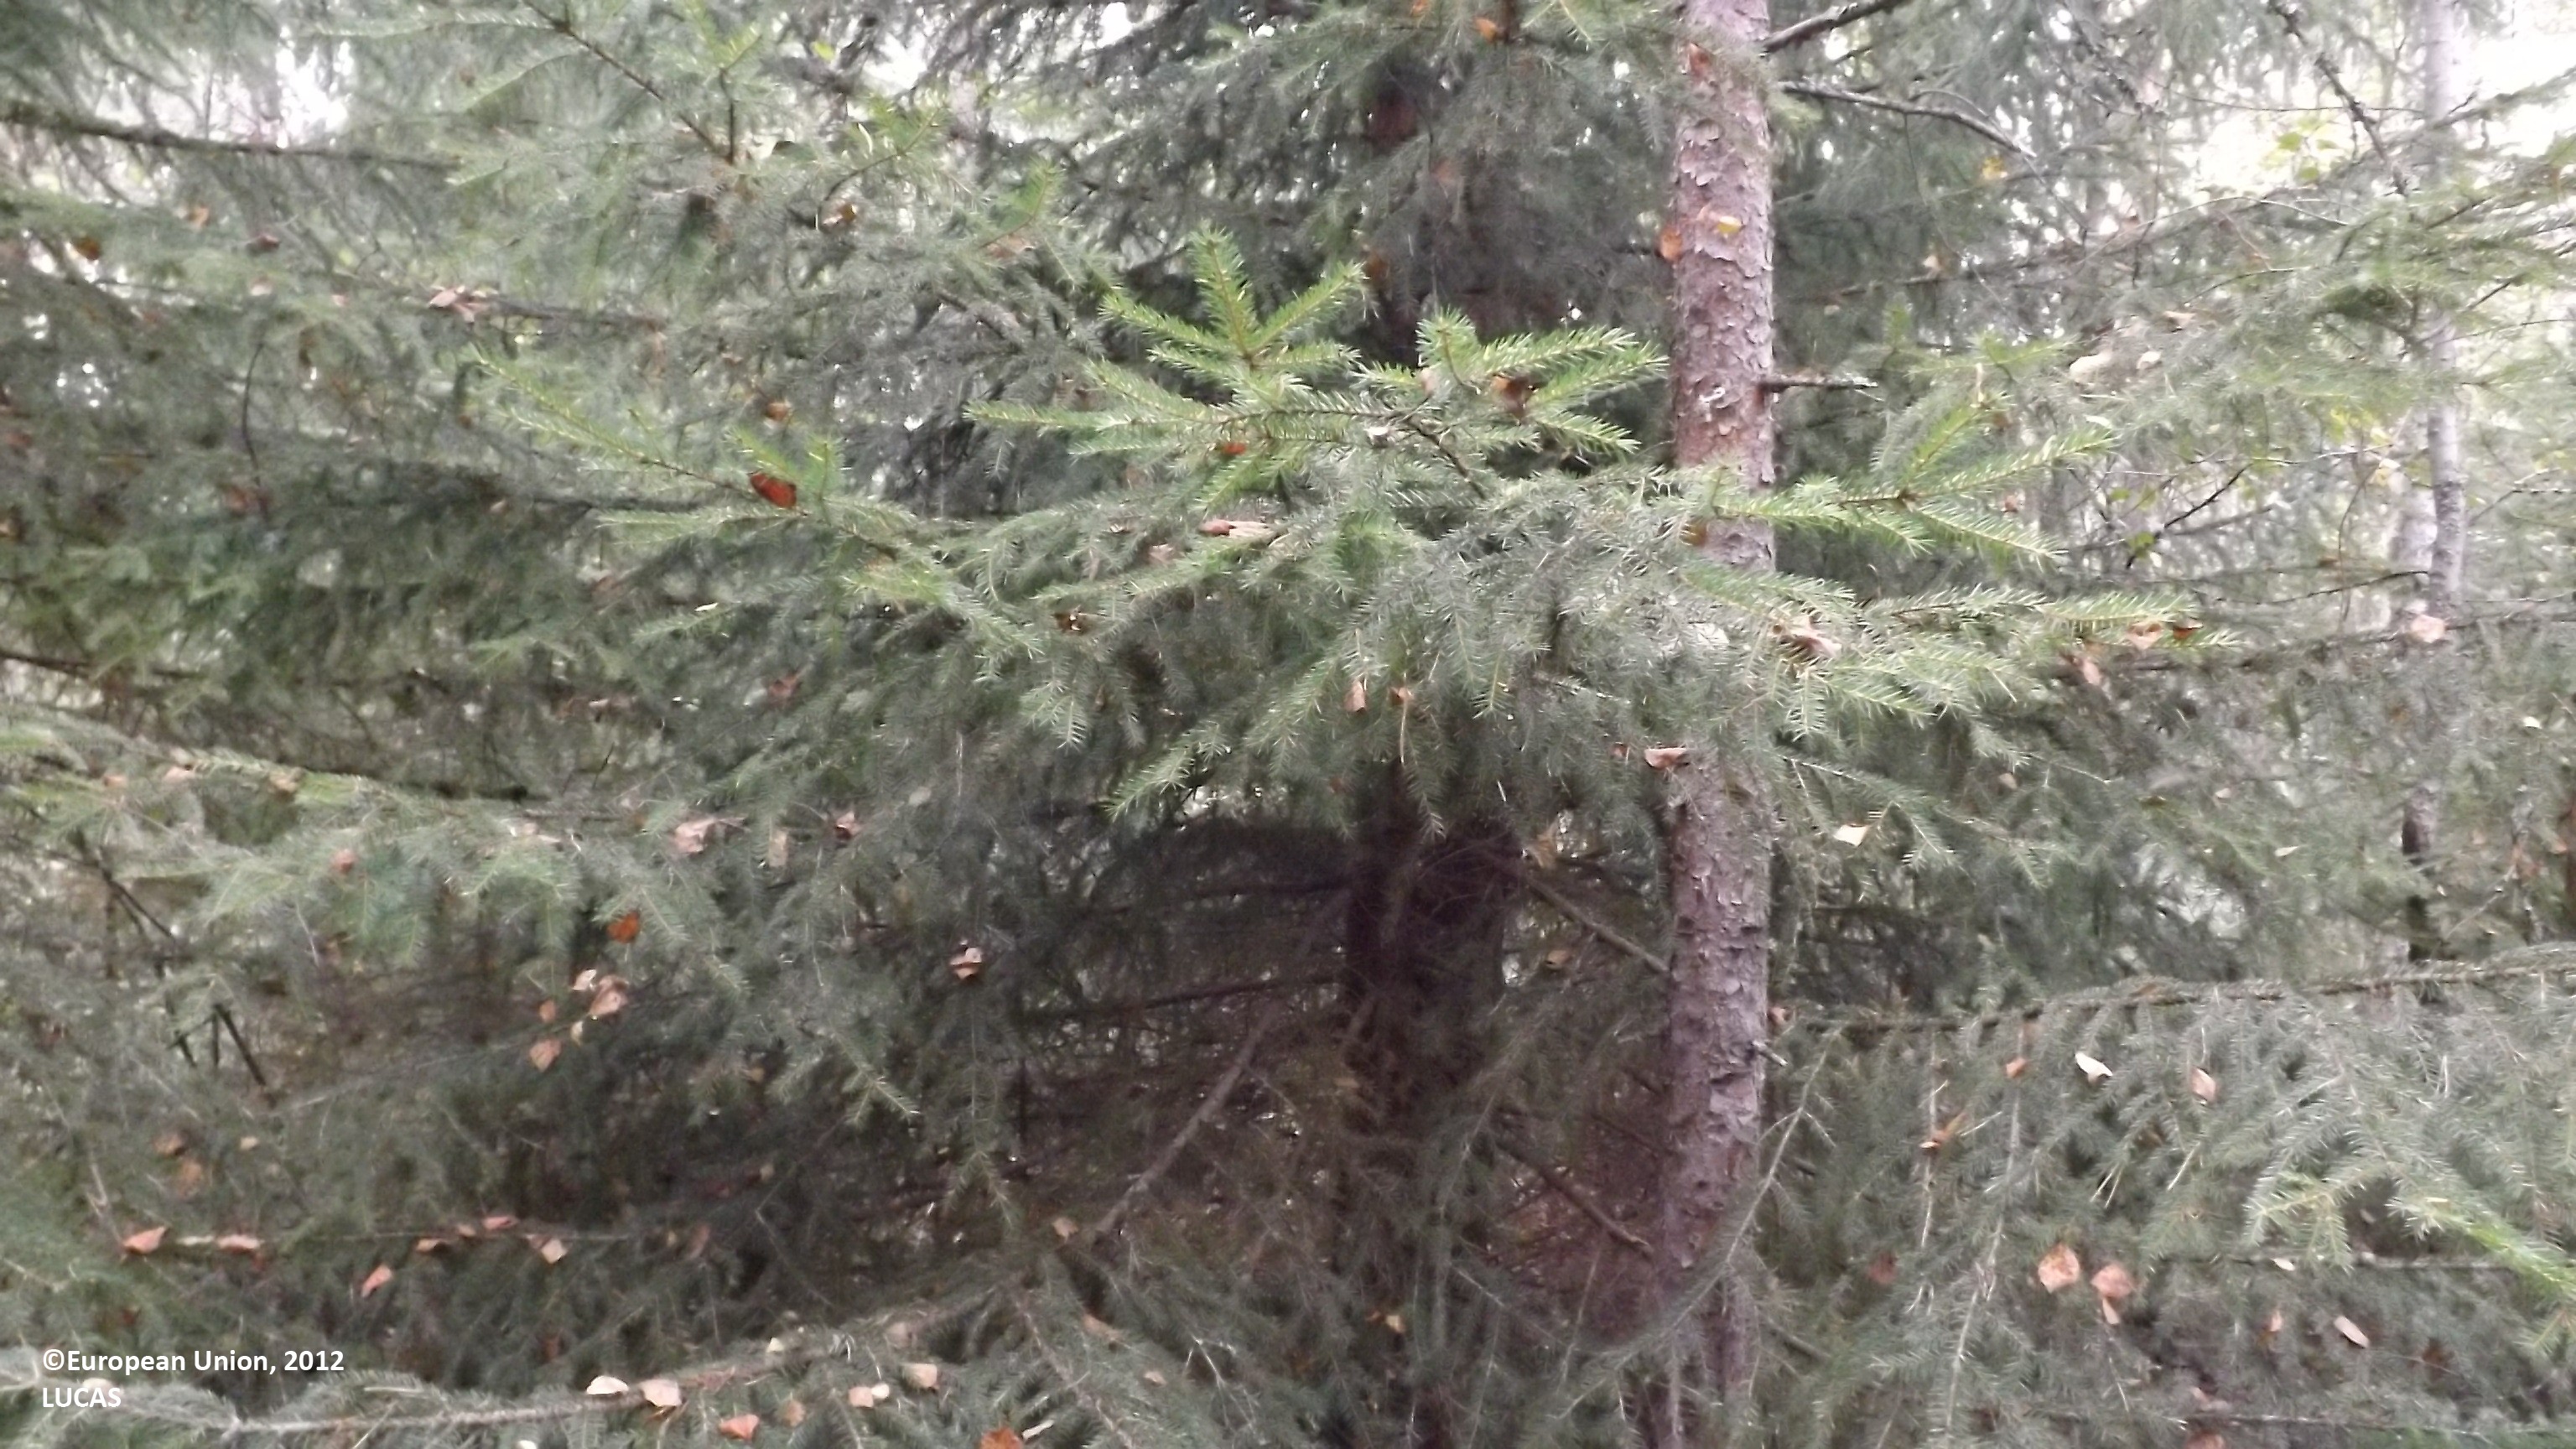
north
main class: Woodland
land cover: Other mixed woodland
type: boreal forest
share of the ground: > 75 %
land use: Forestry
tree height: > 5 m
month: August
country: FI
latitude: 63.8615
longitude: 24.0448
